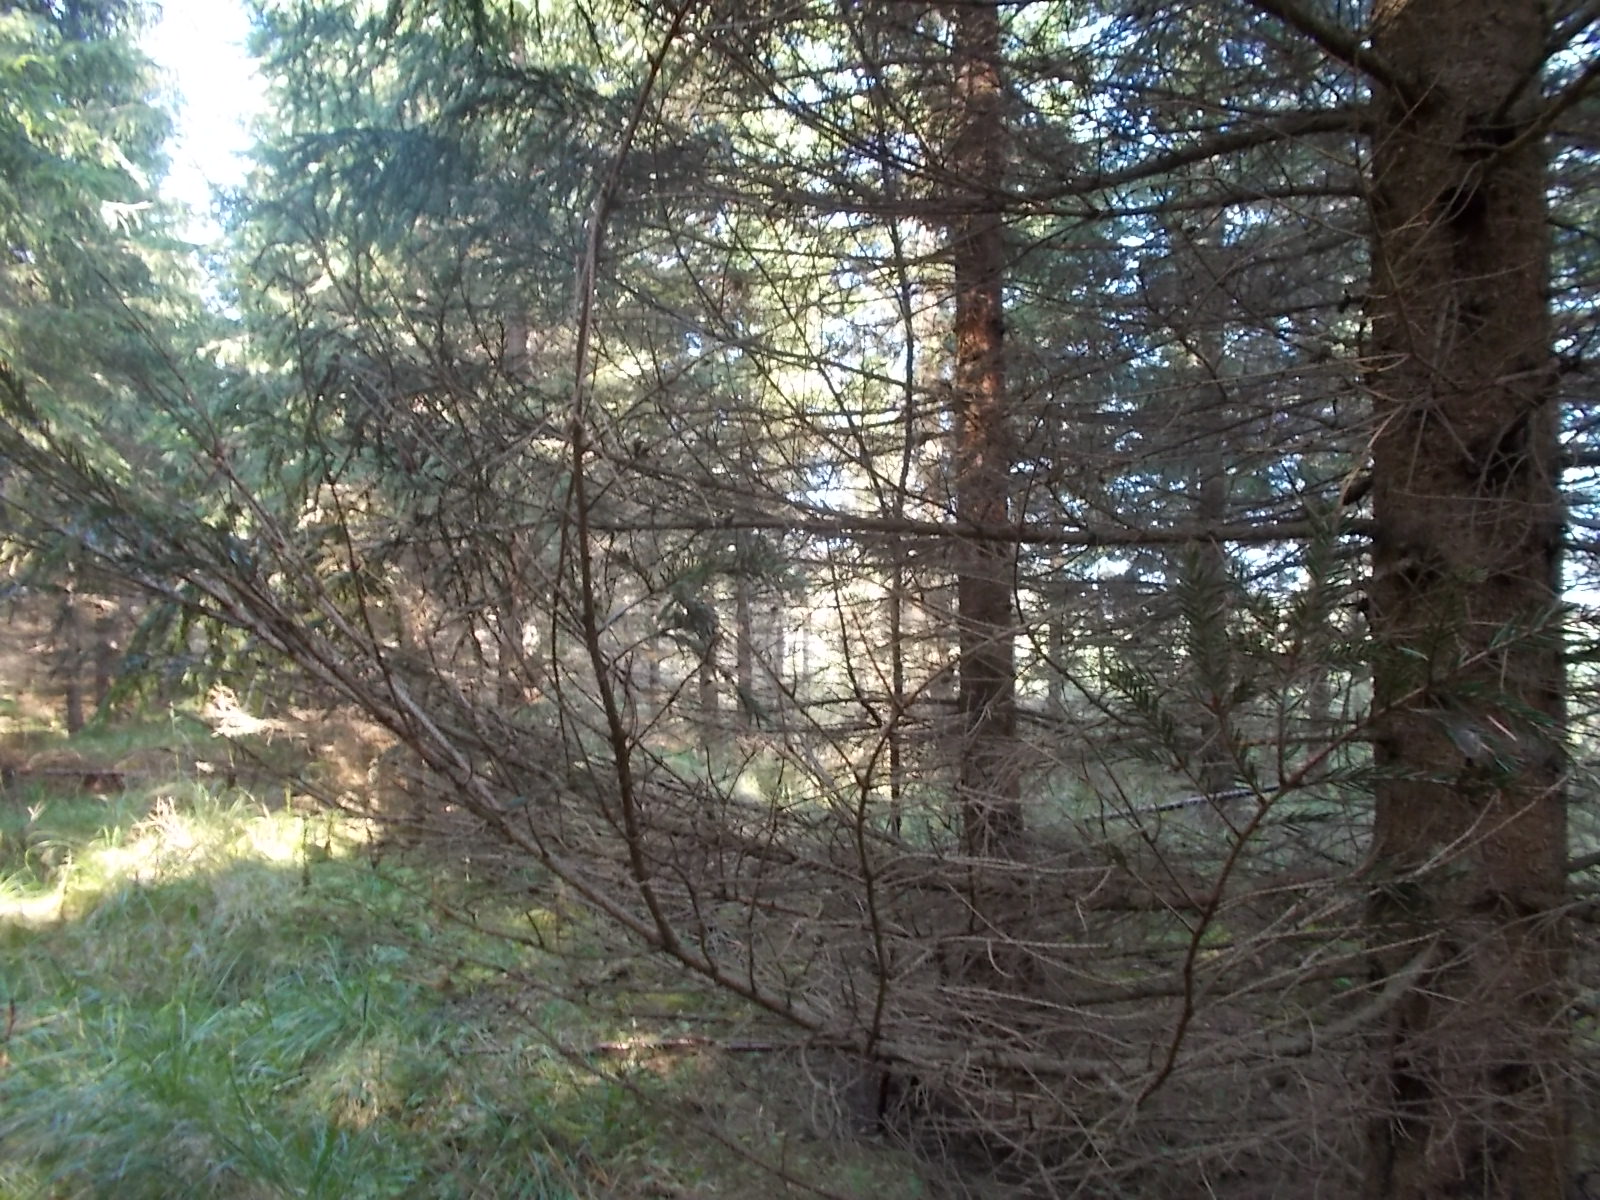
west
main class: Woodland
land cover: Spruce dominated coniferous woodland
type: hemiboreal forest and nemoral coniferous forest and mixed broadleaved-coniferous forest
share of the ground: 50 - 75 %
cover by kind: coniferous forest trees 70 %, shrubs 10 %, herbaceous plants 10 %, lichens and mosses 10 %
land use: Forestry
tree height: > 5 m
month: August
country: LV
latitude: 57.0541
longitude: 22.0668
